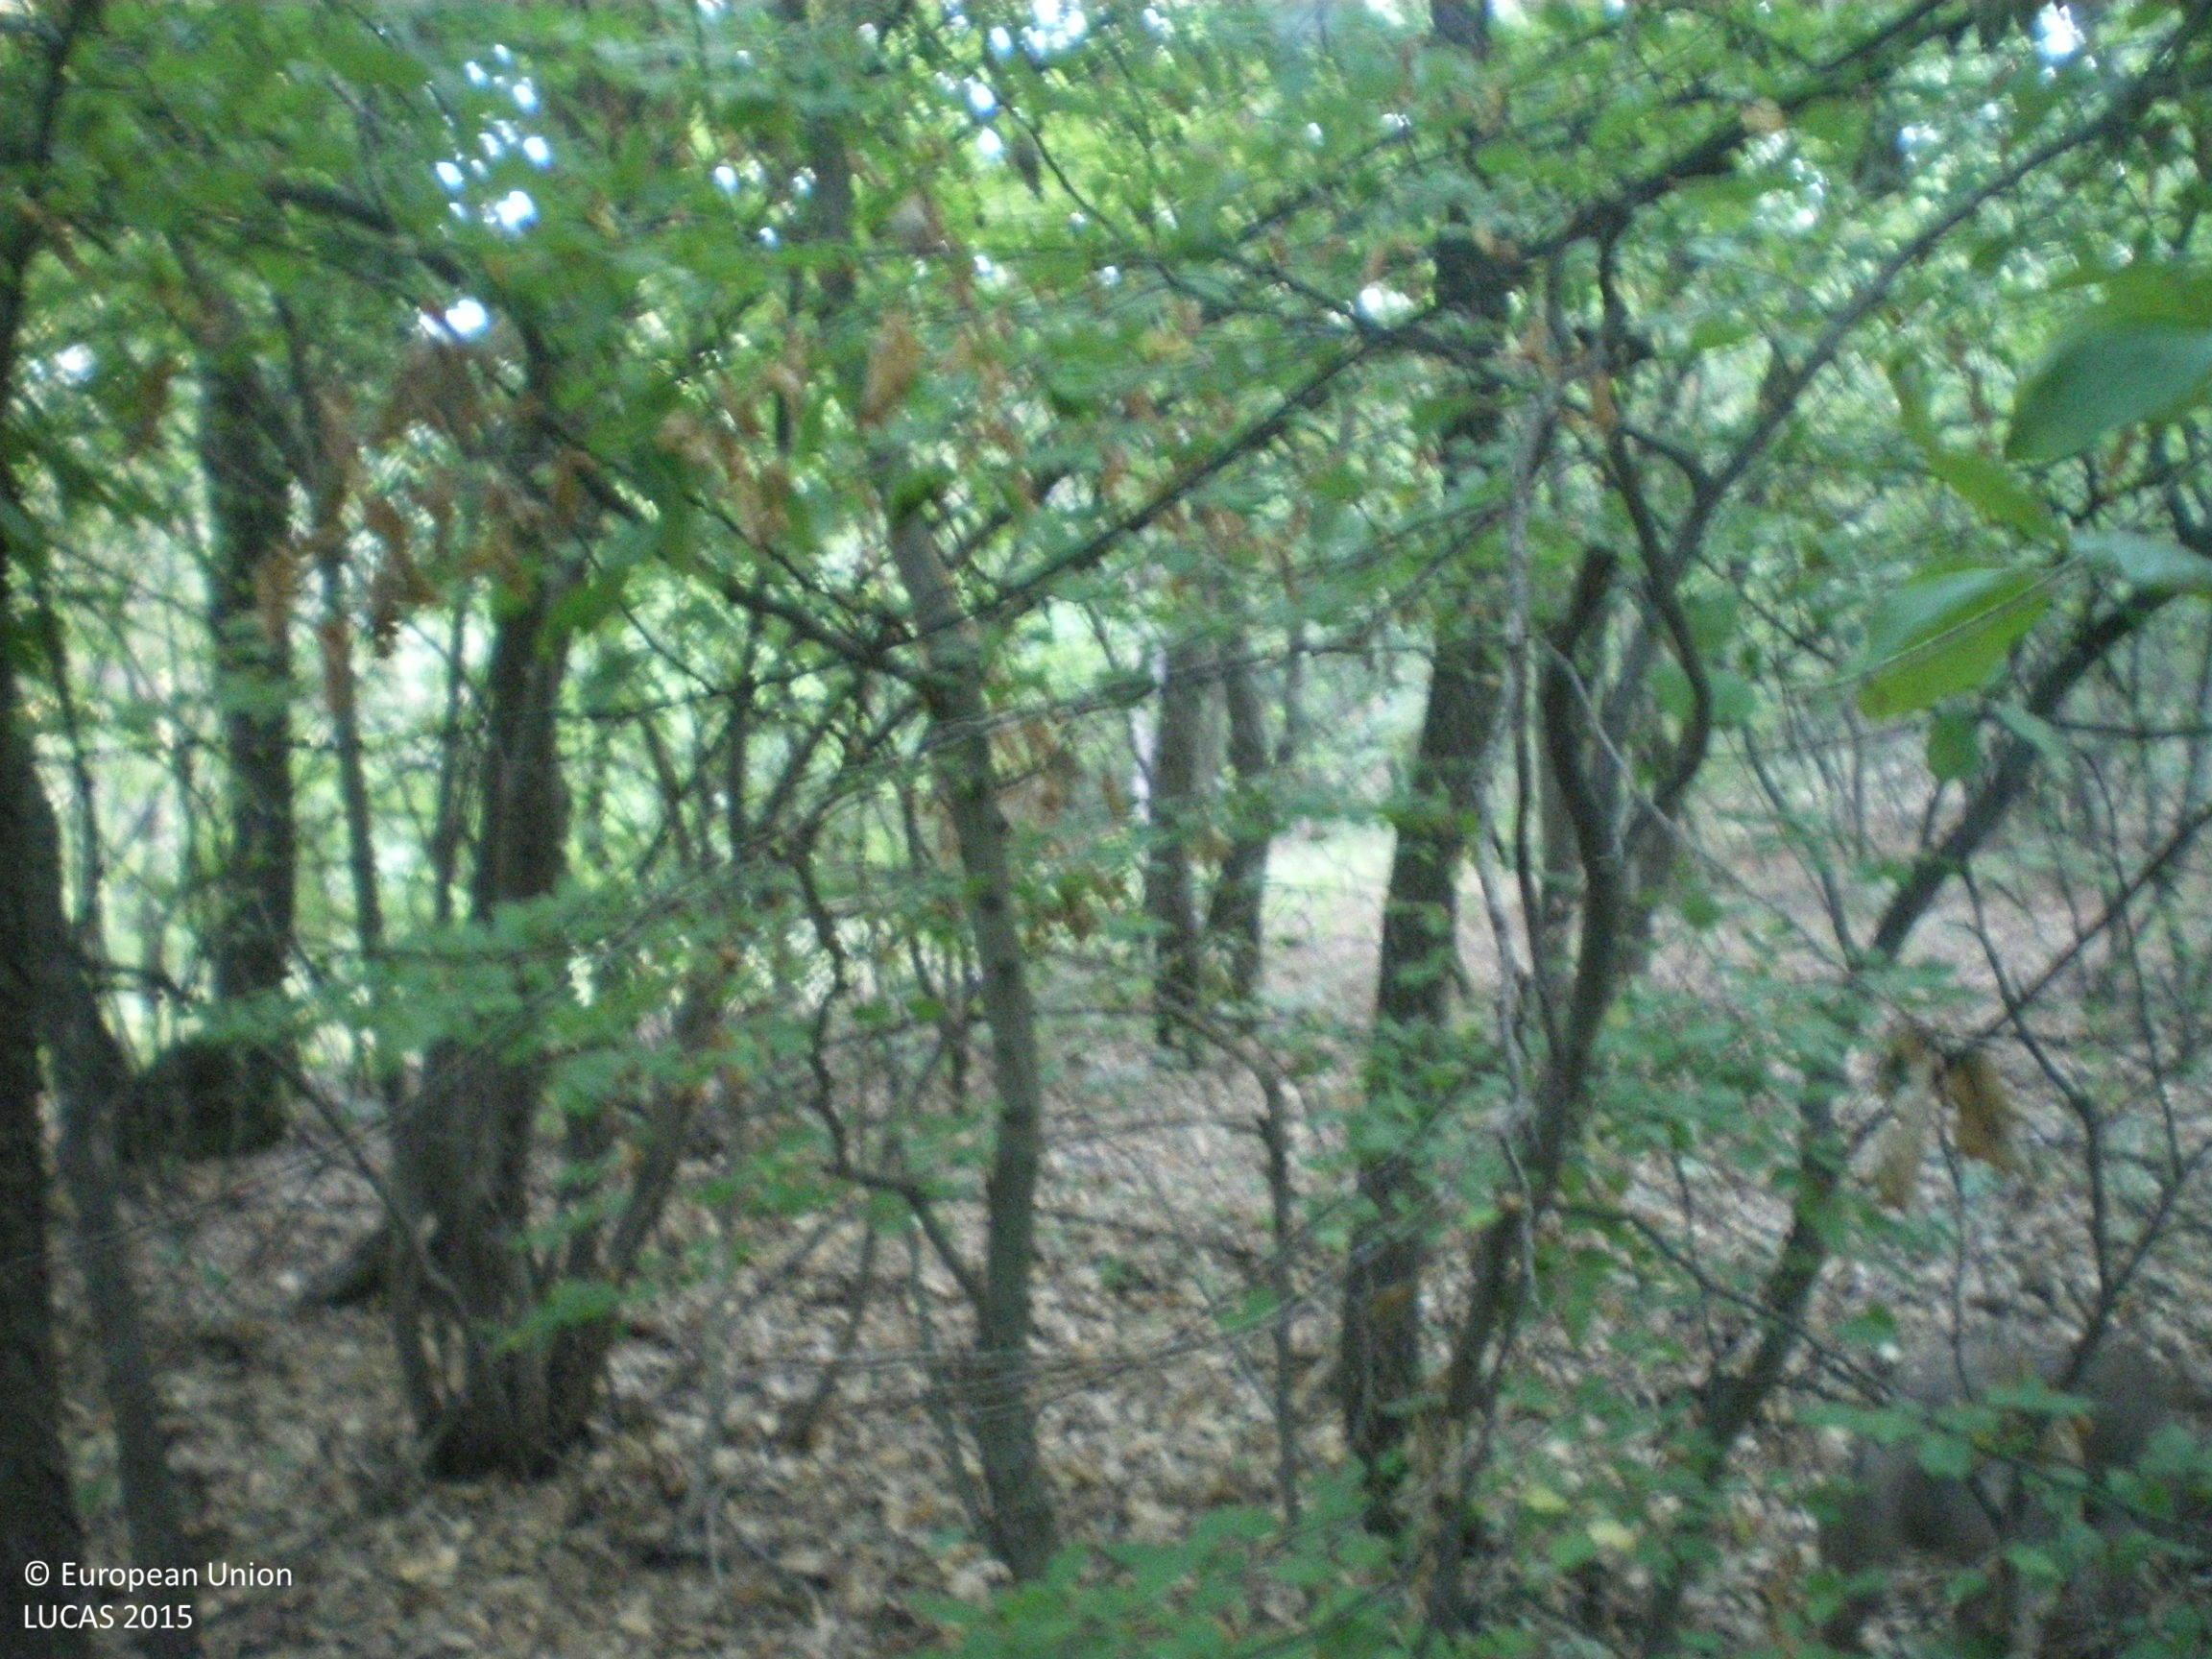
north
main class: Woodland
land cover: Broadleaved woodland
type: mesophytic deciduous forest
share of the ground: > 75 %
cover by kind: broadleaved forest trees 95 %, unconsolidated bare surface 5 %
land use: Forestry
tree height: > 5 m
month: August
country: BG
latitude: 42.4616
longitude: 25.5021
